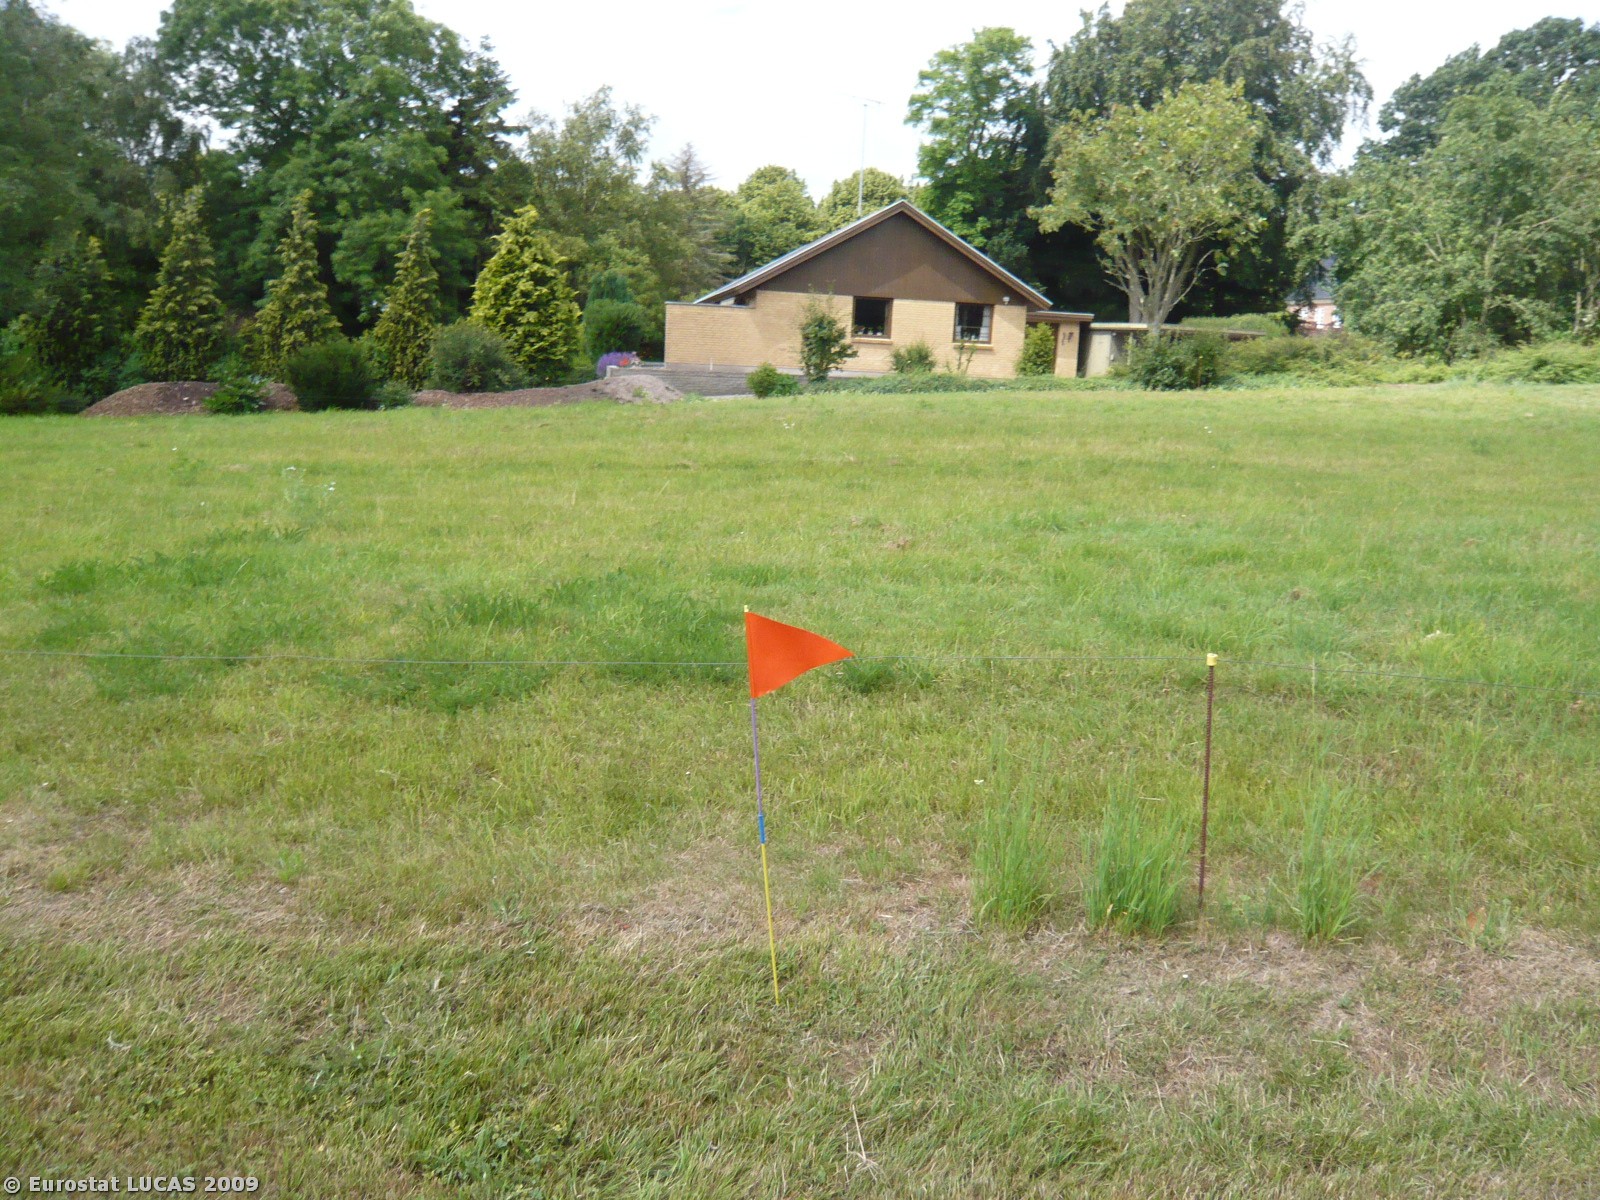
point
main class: Grassland
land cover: Grassland without tree/shrub cover
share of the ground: > 75 %
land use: Agriculture (excluding fallow land and kitchen gardens)
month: July
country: DK
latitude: 55.3538
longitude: 11.3395
